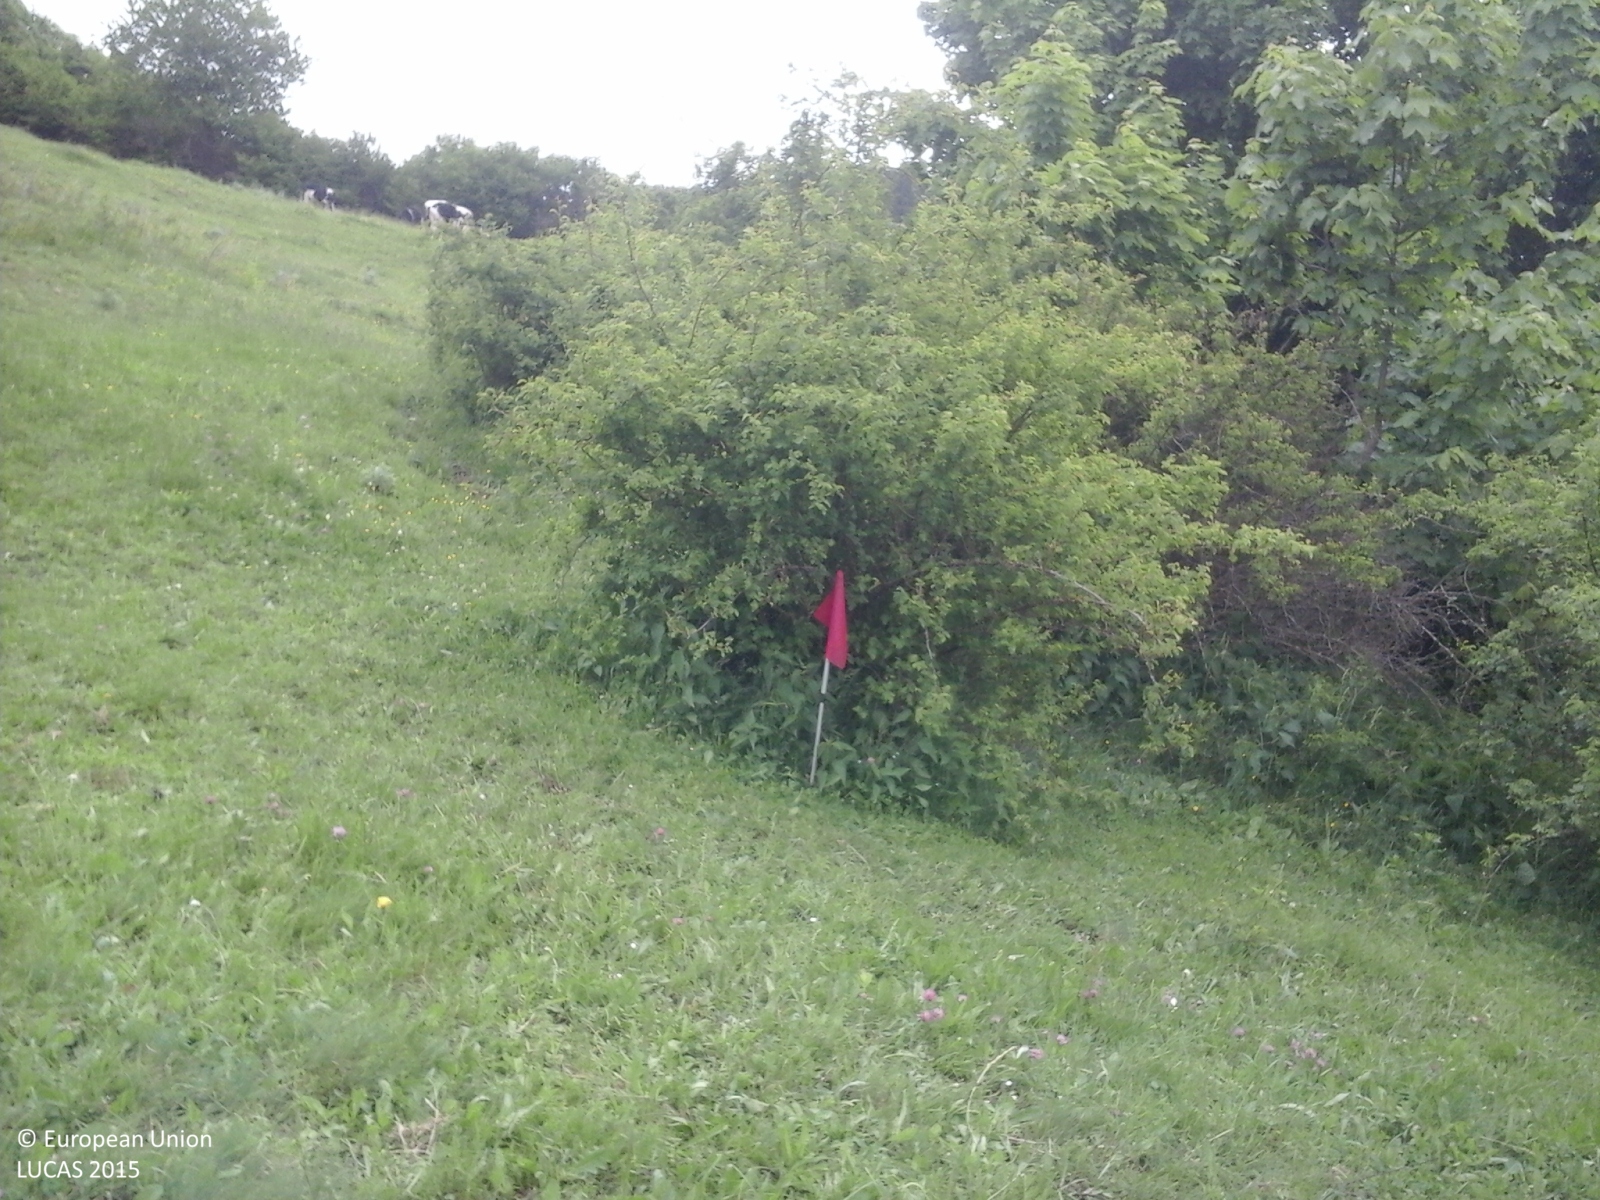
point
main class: Woodland
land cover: Broadleaved woodland
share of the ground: > 75 %
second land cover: Grassland without tree/shrub cover
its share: > 75 %
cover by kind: broadleaved forest trees 45 %, herbaceous plants 45 %, shrubs 10 %
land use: Forestry
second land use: Agriculture (excluding fallow land and kitchen gardens)
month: May
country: IT
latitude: 45.6622
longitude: 10.9610
